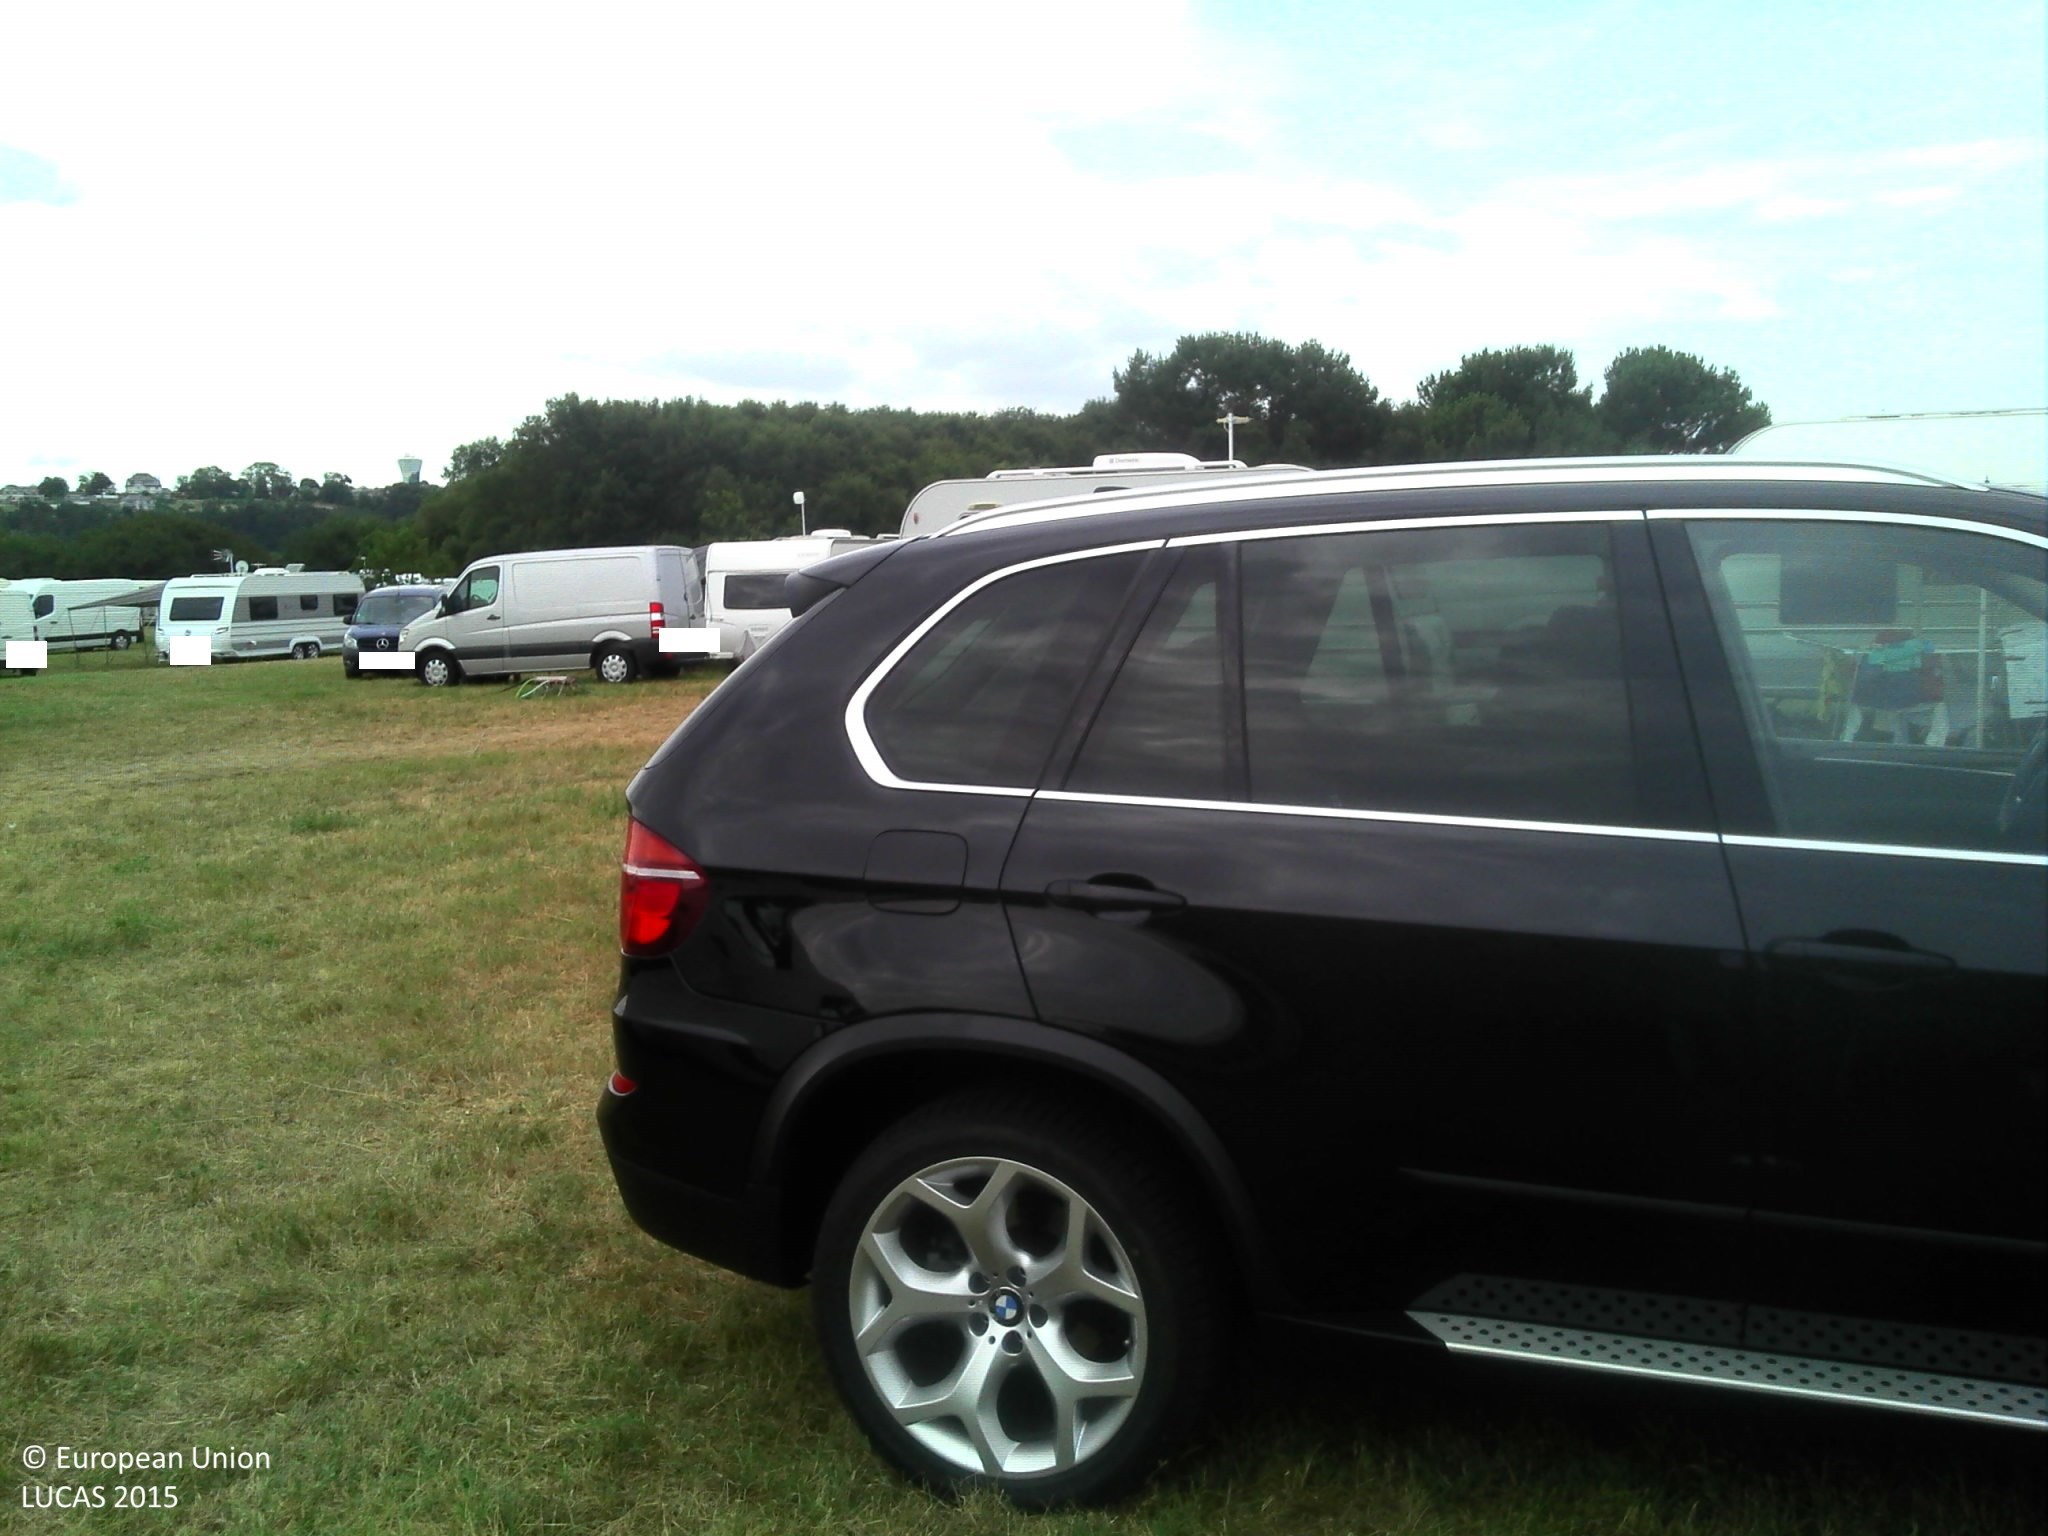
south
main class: Grassland
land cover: Grassland without tree/shrub cover
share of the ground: > 75 %
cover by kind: herbaceous plants 100 %
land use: Community services
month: July
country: FR
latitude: 48.8663
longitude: -1.5683
